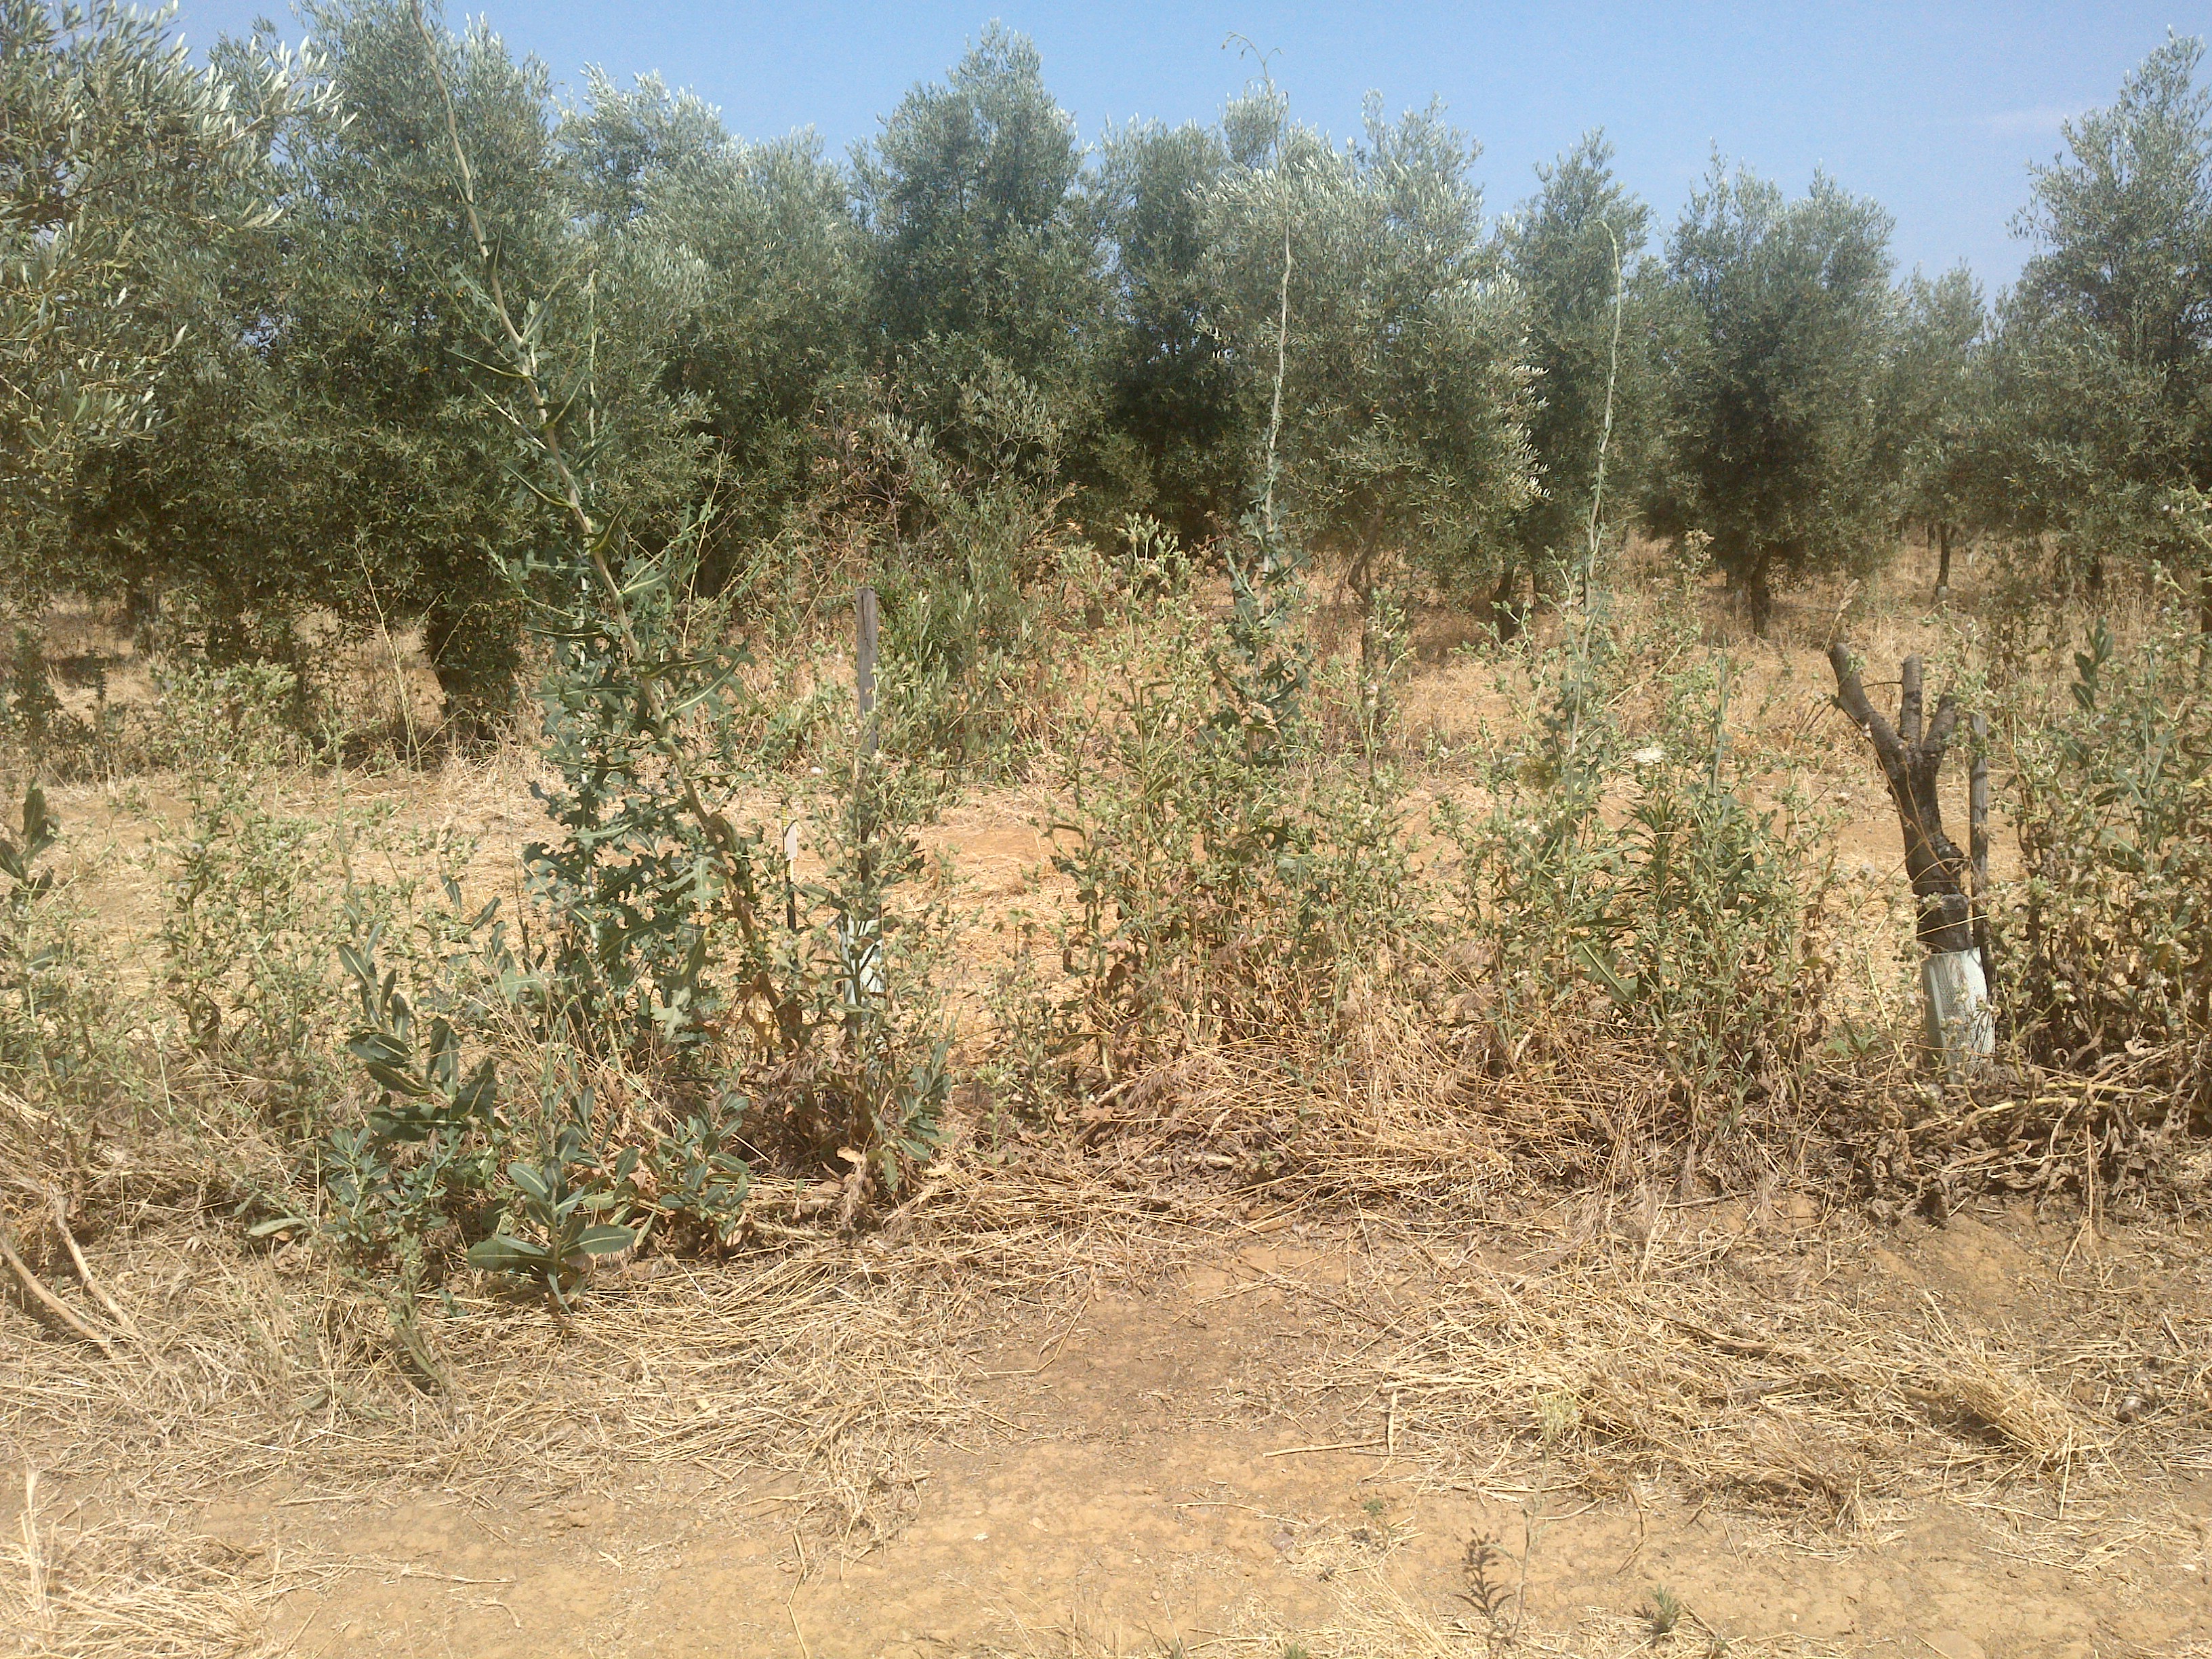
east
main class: Cropland
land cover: Olive groves
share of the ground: 25 - 50 %
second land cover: Spontaneously vegetated surfaces
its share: > 75 %
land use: Agriculture (excluding fallow land and kitchen gardens)
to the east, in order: Olive groves; Spontaneously vegetated surfaces
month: June
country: ES
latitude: 37.7845
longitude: -4.9926
